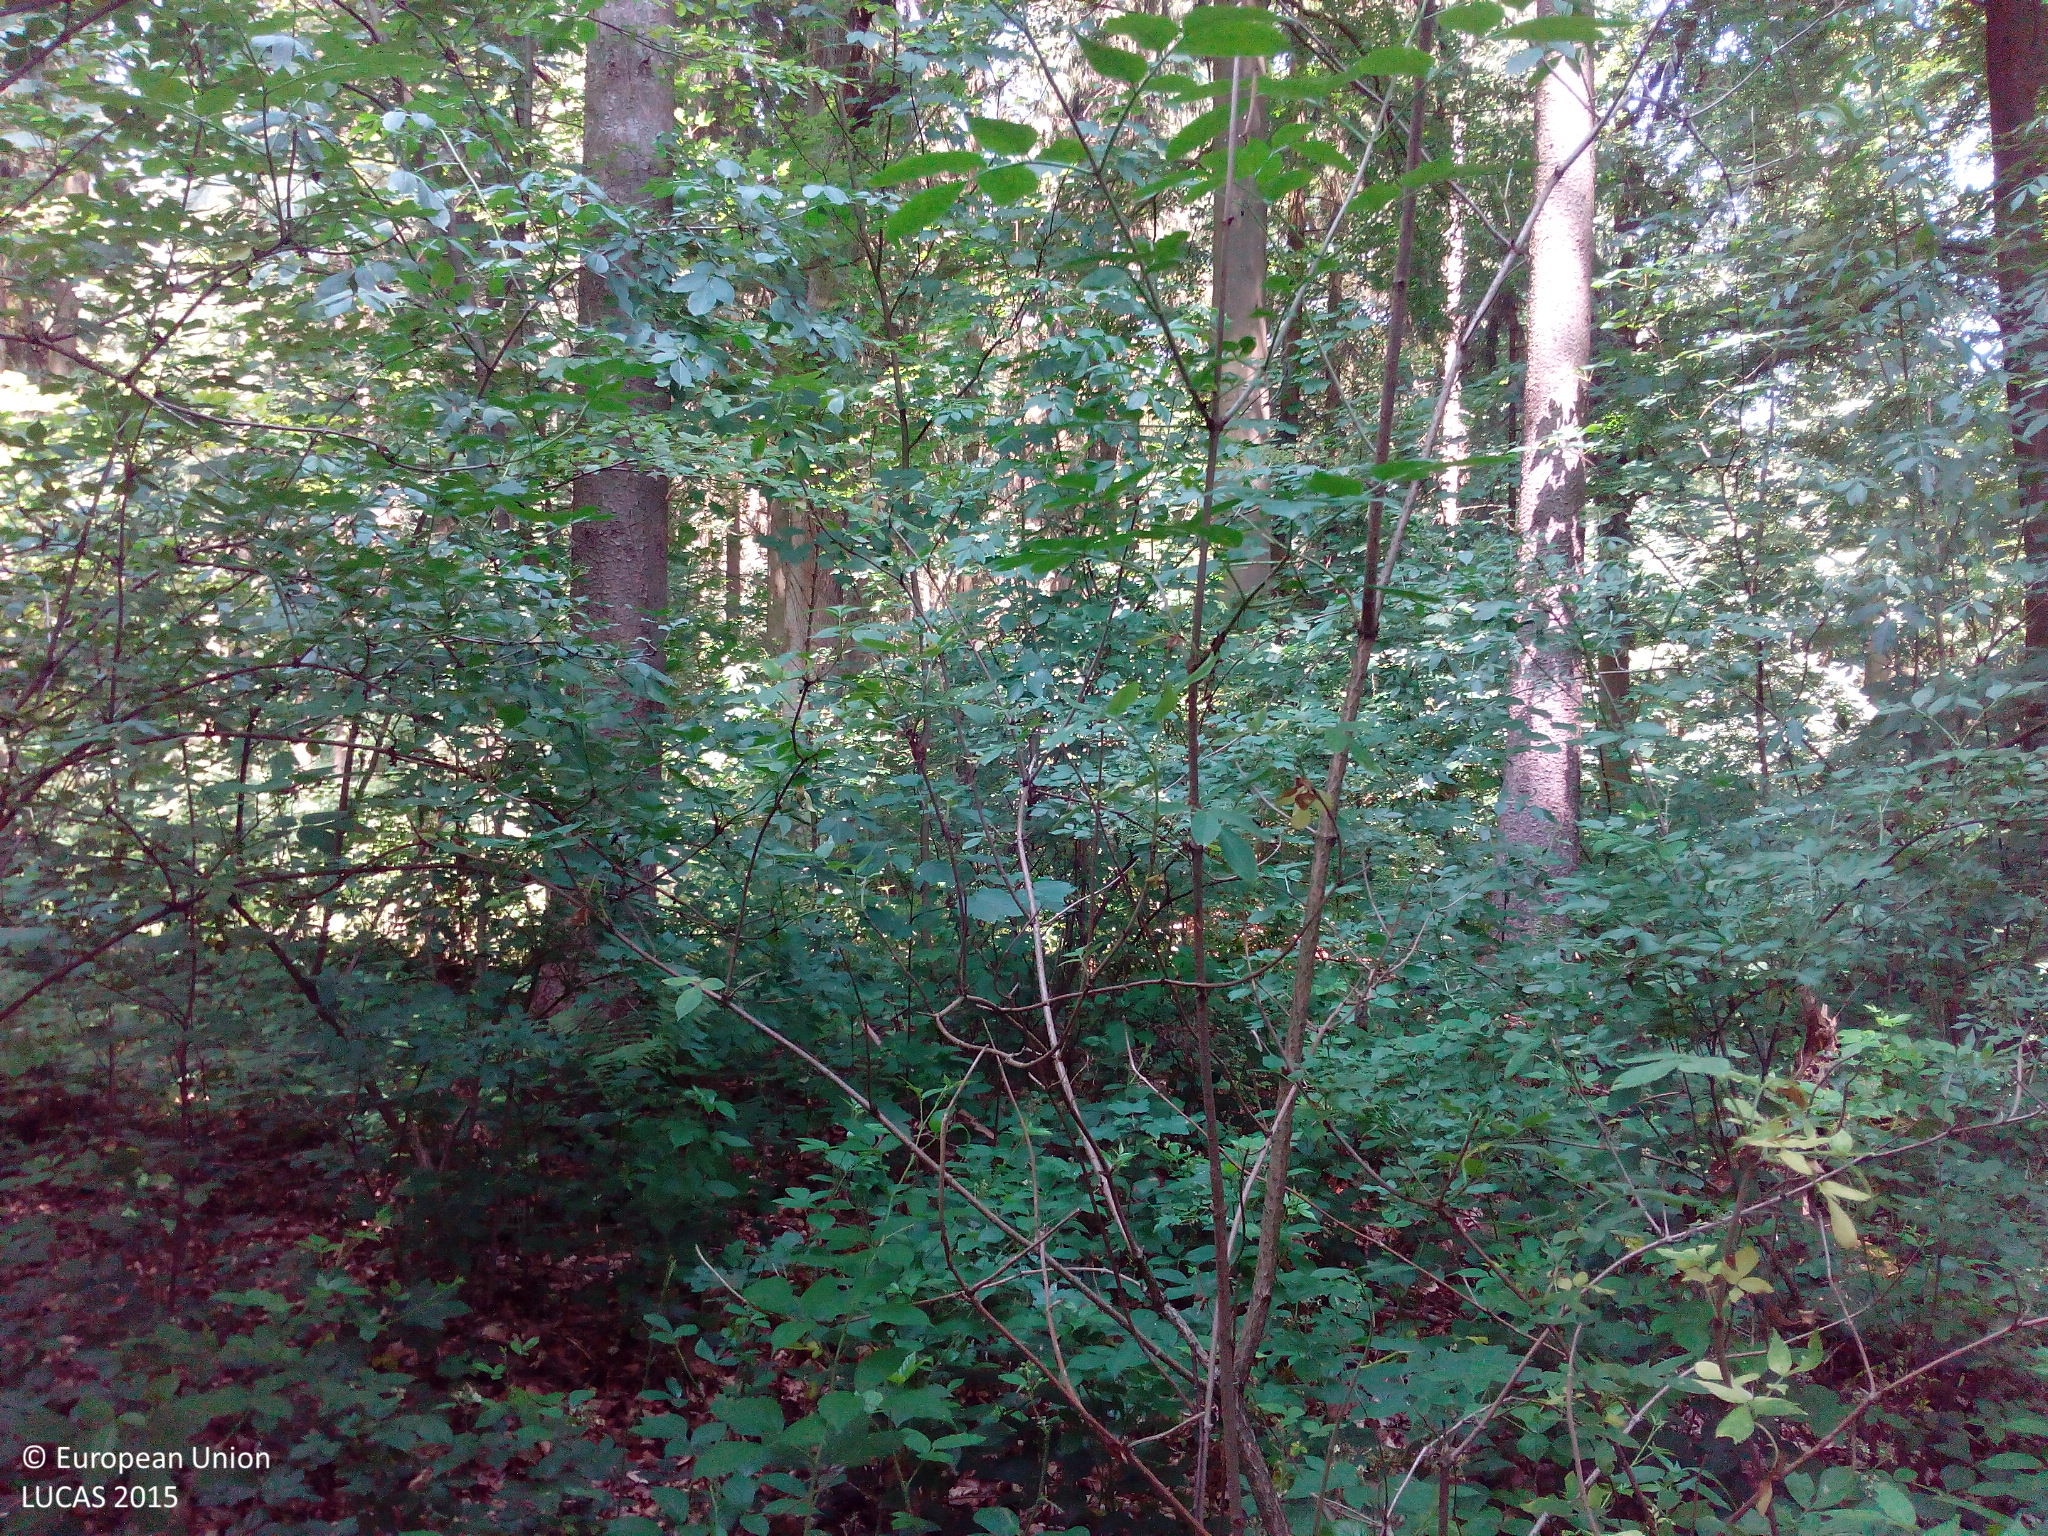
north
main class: Woodland
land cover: Pine dominated mixed woodland
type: hemiboreal forest and nemoral coniferous forest and mixed broadleaved-coniferous forest
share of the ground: > 75 %
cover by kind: broadleaved forest trees 65 %, coniferous forest trees 25 %, shrubs 5 %, herbaceous plants 5 %
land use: Forestry
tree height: > 5 m
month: July
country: DE
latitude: 49.5547
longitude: 9.9033
